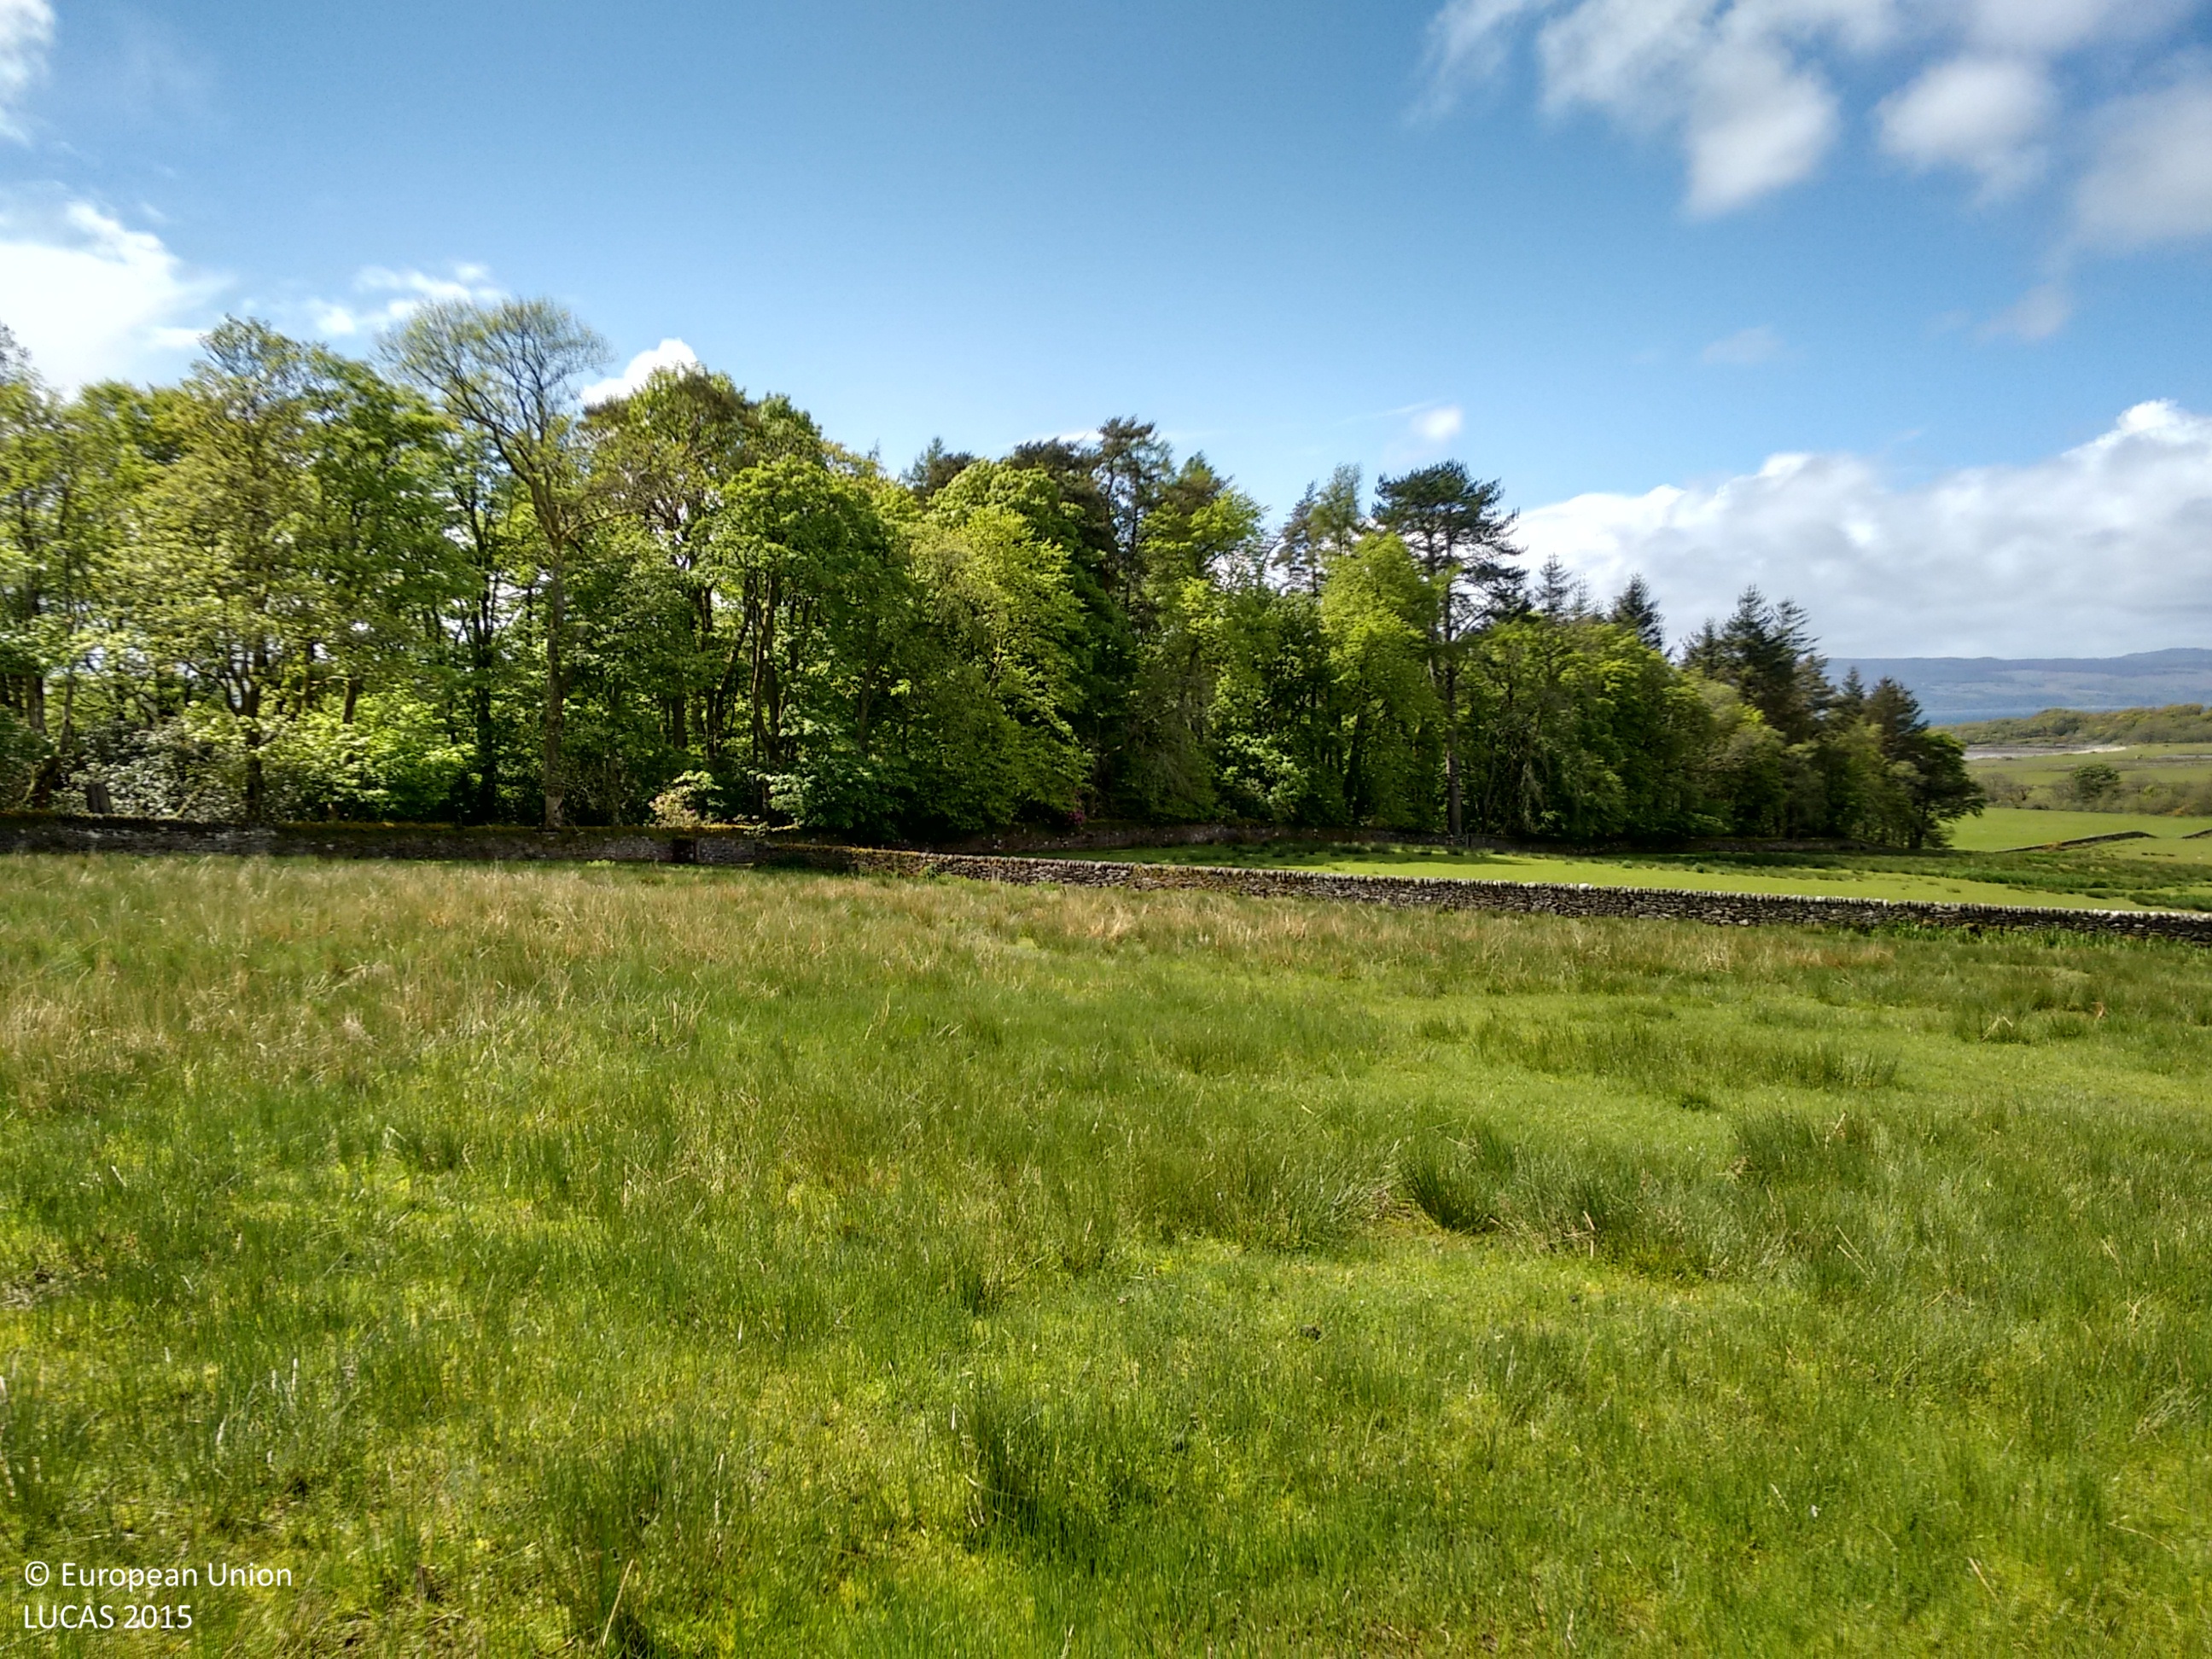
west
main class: Grassland
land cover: Grassland without tree/shrub cover
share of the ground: > 75 %
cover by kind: herbaceous plants 100 %
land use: Agriculture (excluding fallow land and kitchen gardens)
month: May
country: GB
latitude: 55.9570
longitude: -5.3180
